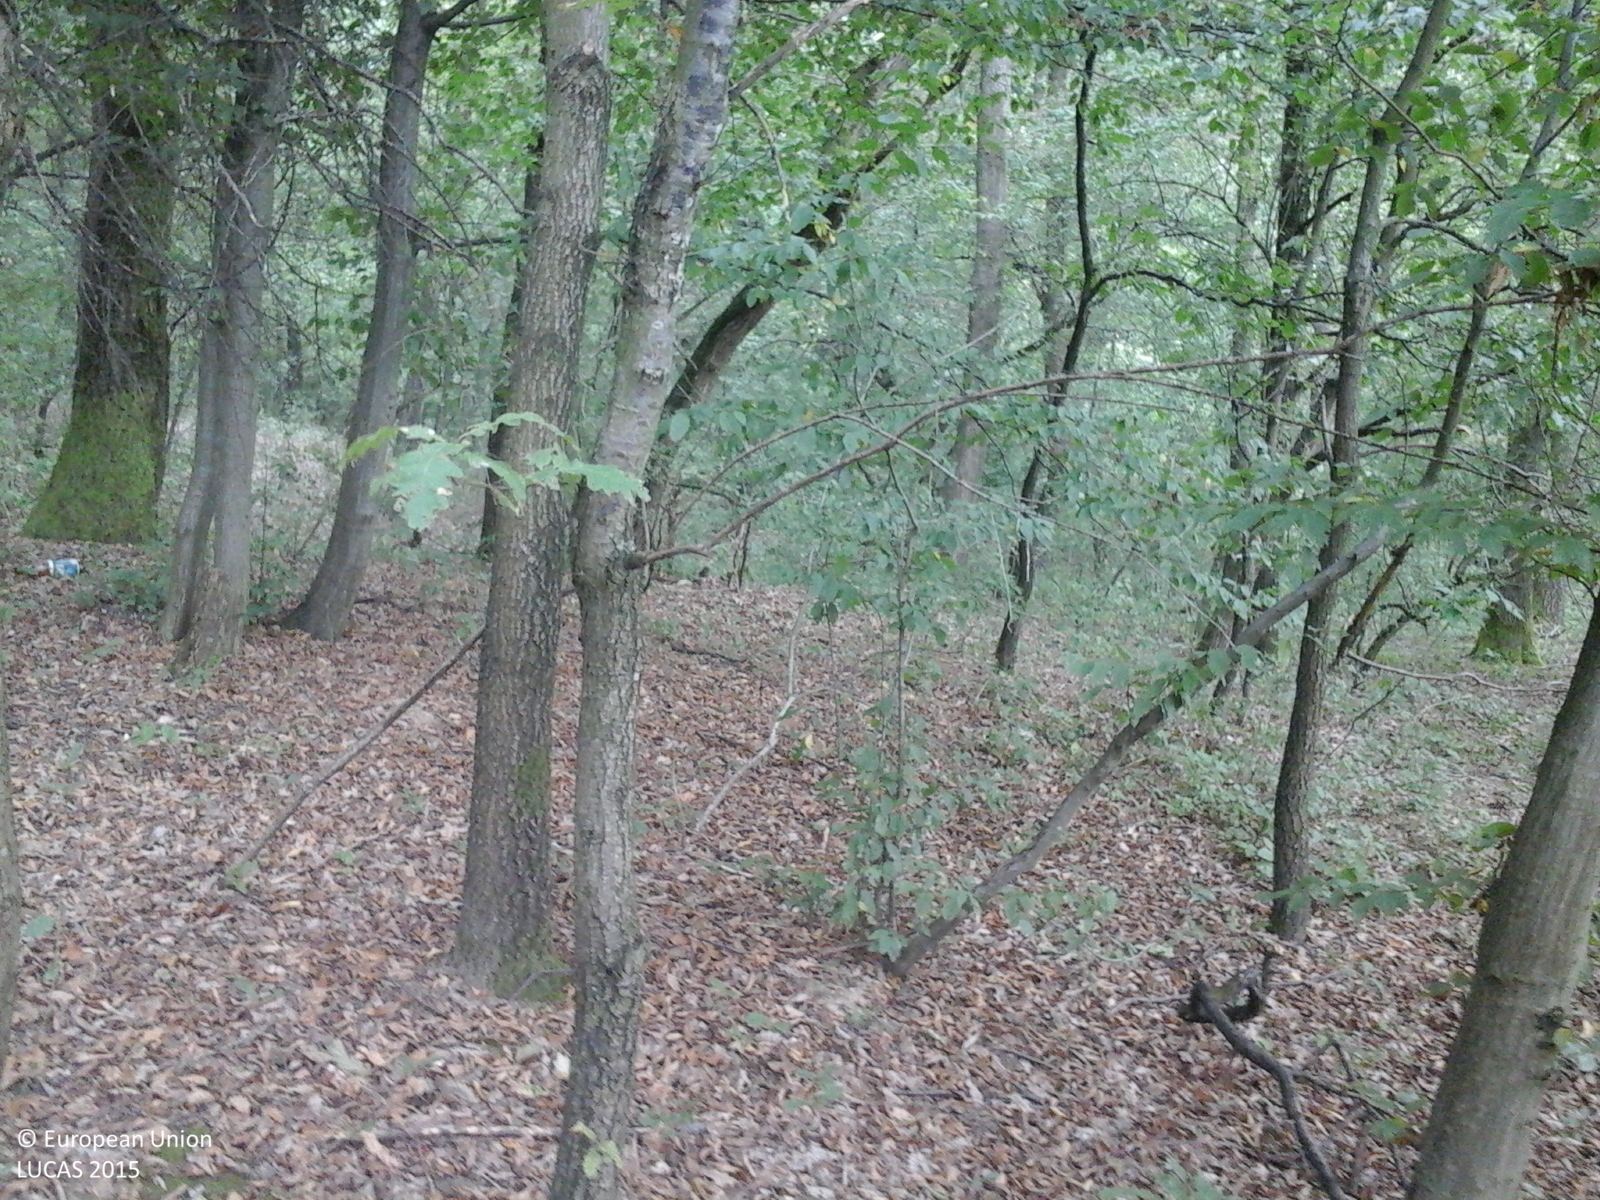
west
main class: Woodland
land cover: Broadleaved woodland
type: acidophilous oak and oak-birch forest
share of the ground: > 75 %
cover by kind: broadleaved forest trees 100 %
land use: Forestry
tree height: > 5 m
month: September
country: RO
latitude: 47.2400
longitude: 23.0770
